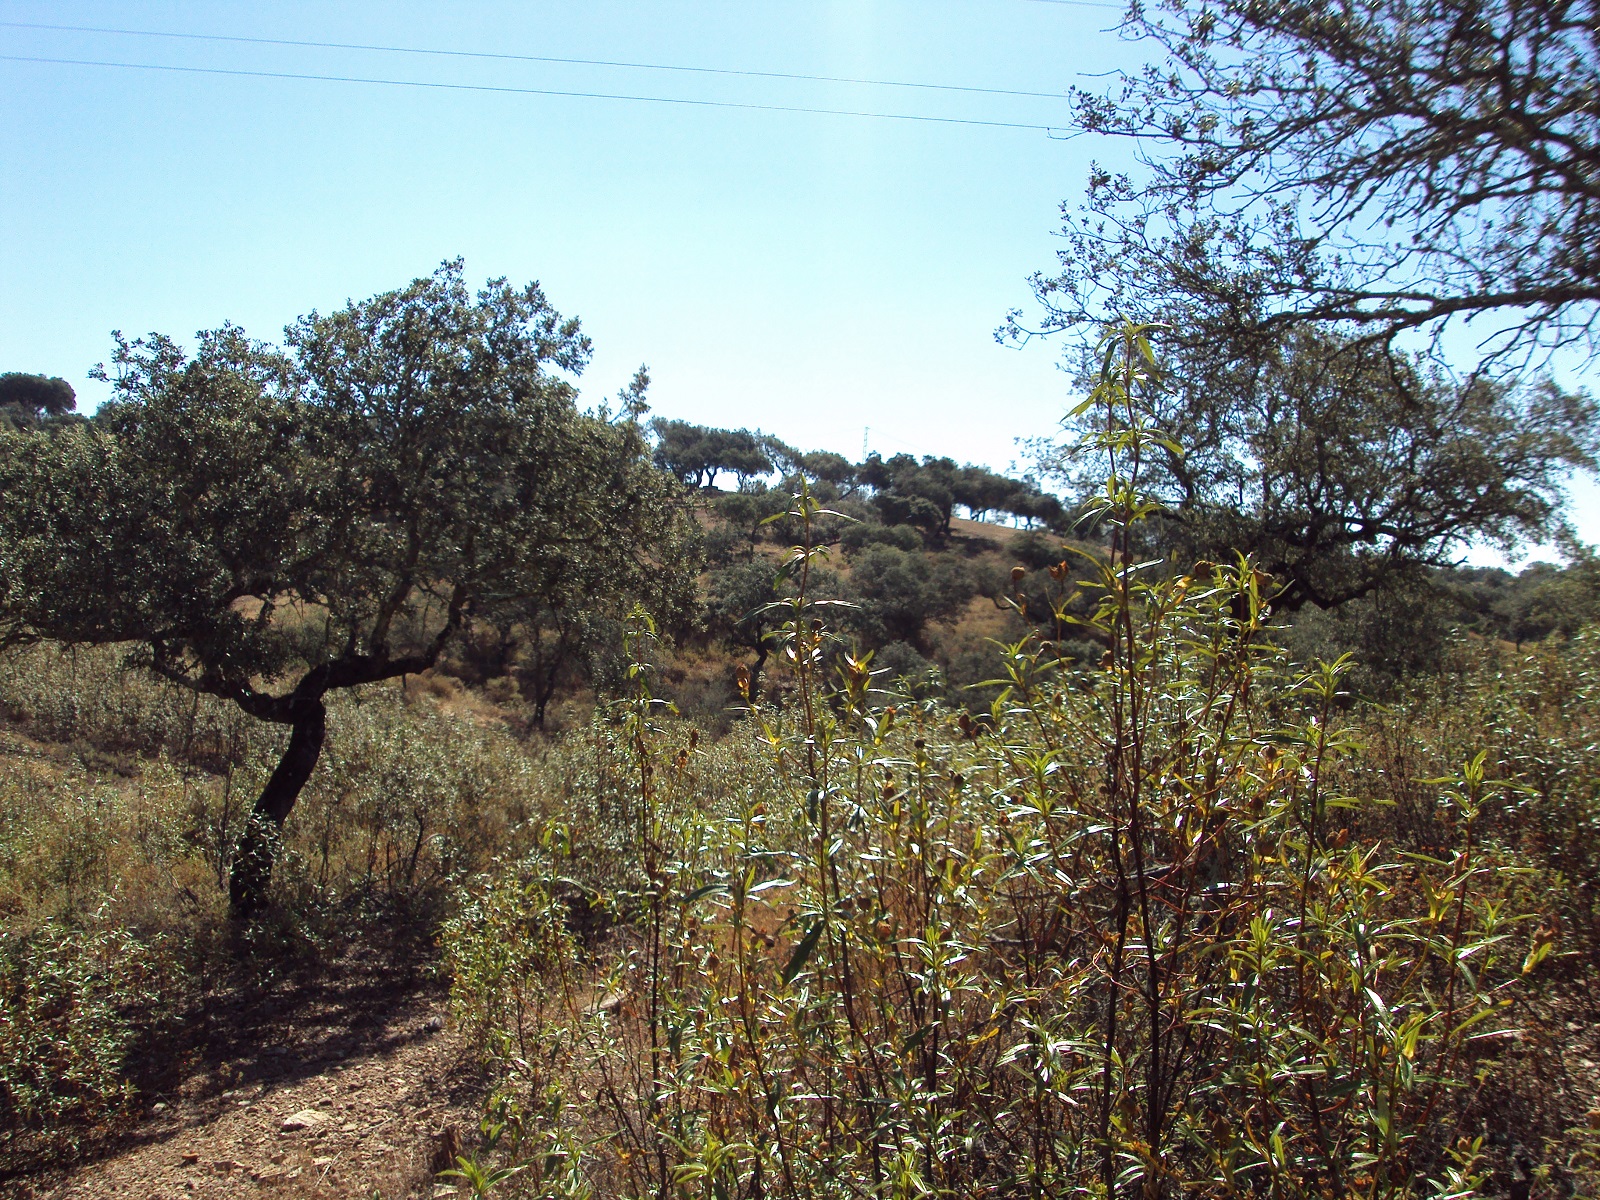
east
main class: Woodland
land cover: Broadleaved woodland
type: broadleaved evergreen forest
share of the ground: 50 - 75 %
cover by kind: broadleaved forest trees 50 %, shrubs 40 %, herbaceous plants 10 %
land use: Agriculture (excluding fallow land and kitchen gardens)
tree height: > 5 m
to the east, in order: Broadleaved woodland; Tracks; Broadleaved woodland; Electric lines; Broadleaved woodland; Other structural elements; Broadleaved woodland; Dry stone walls; Fences; Grass margins; Tracks; Shruby margins; Ditches and canals; Shruby margins; Lines of trees; Dry stone walls; Fences; Broadleaved woodland; Electric lines; Broadleaved woodland; Fences; Broadleaved woodland
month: June
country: ES
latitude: 37.5309
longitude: -7.1234
